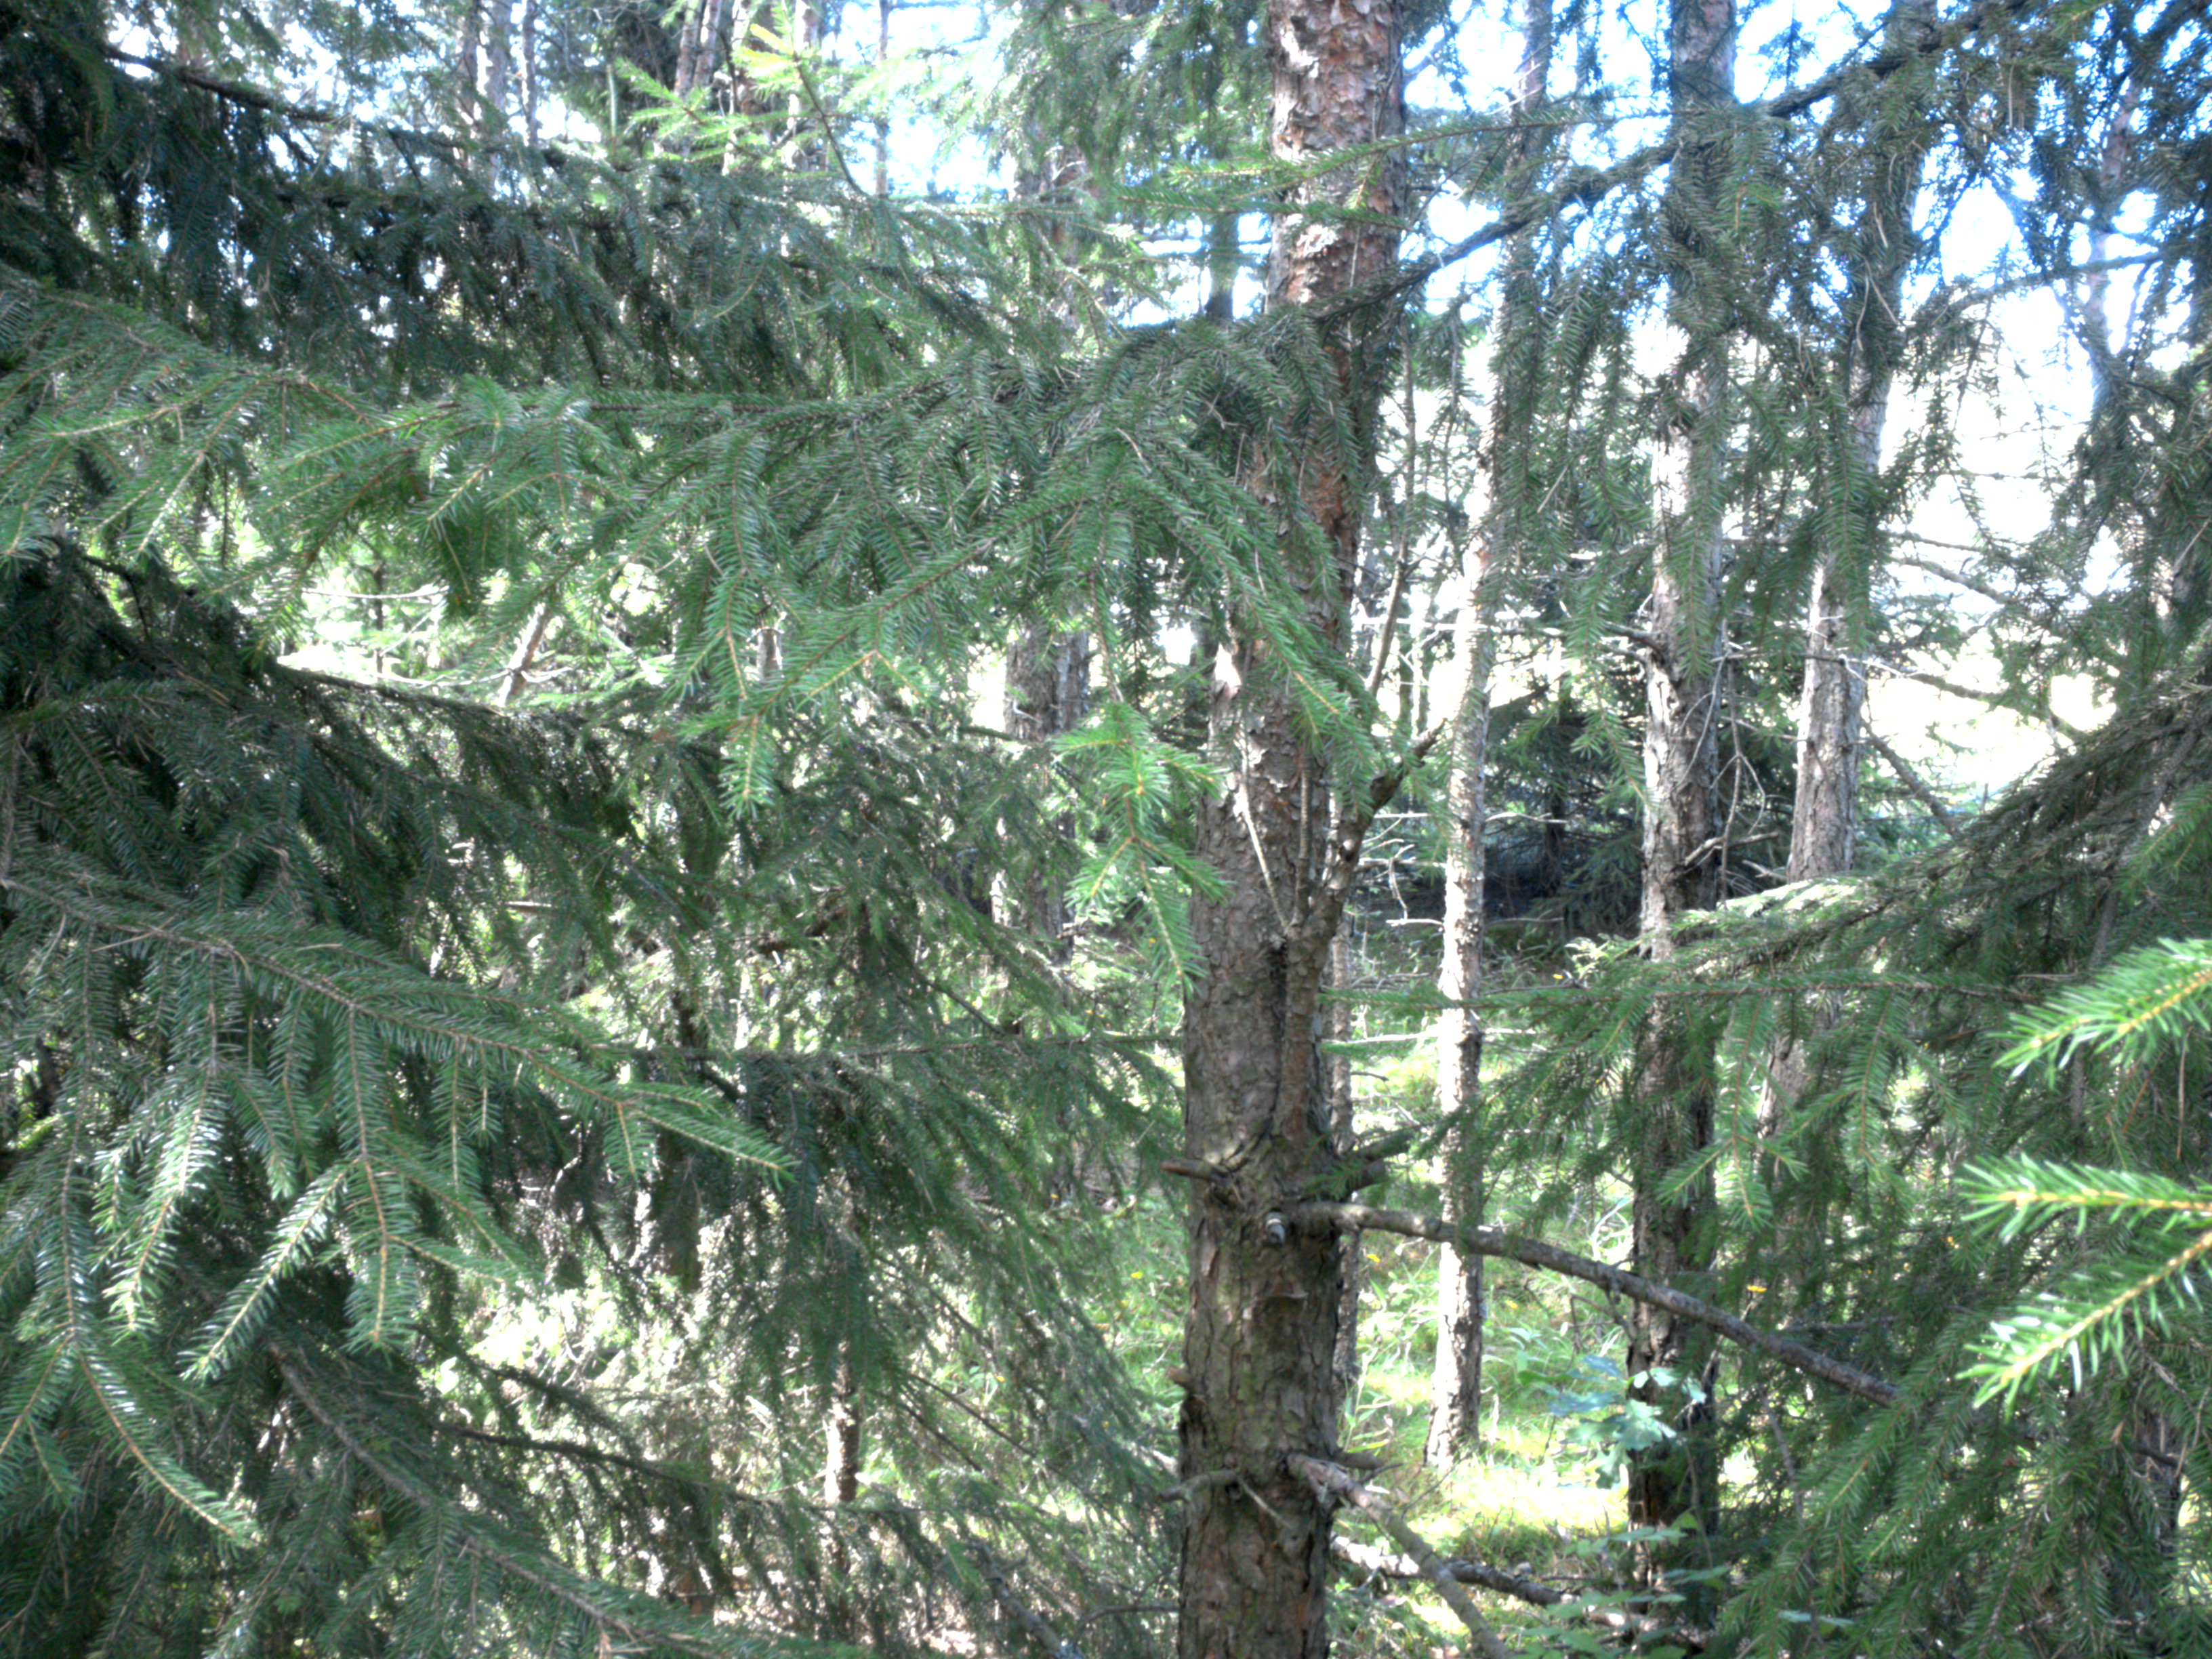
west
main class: Woodland
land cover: Pine dominated coniferous woodland
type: boreal forest
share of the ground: > 75 %
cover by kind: coniferous forest trees 75 %, lichens and mosses 20 %, broadleaved forest trees 5 %
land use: Forestry
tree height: > 5 m
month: August
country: SE
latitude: 59.1236
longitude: 17.6320
